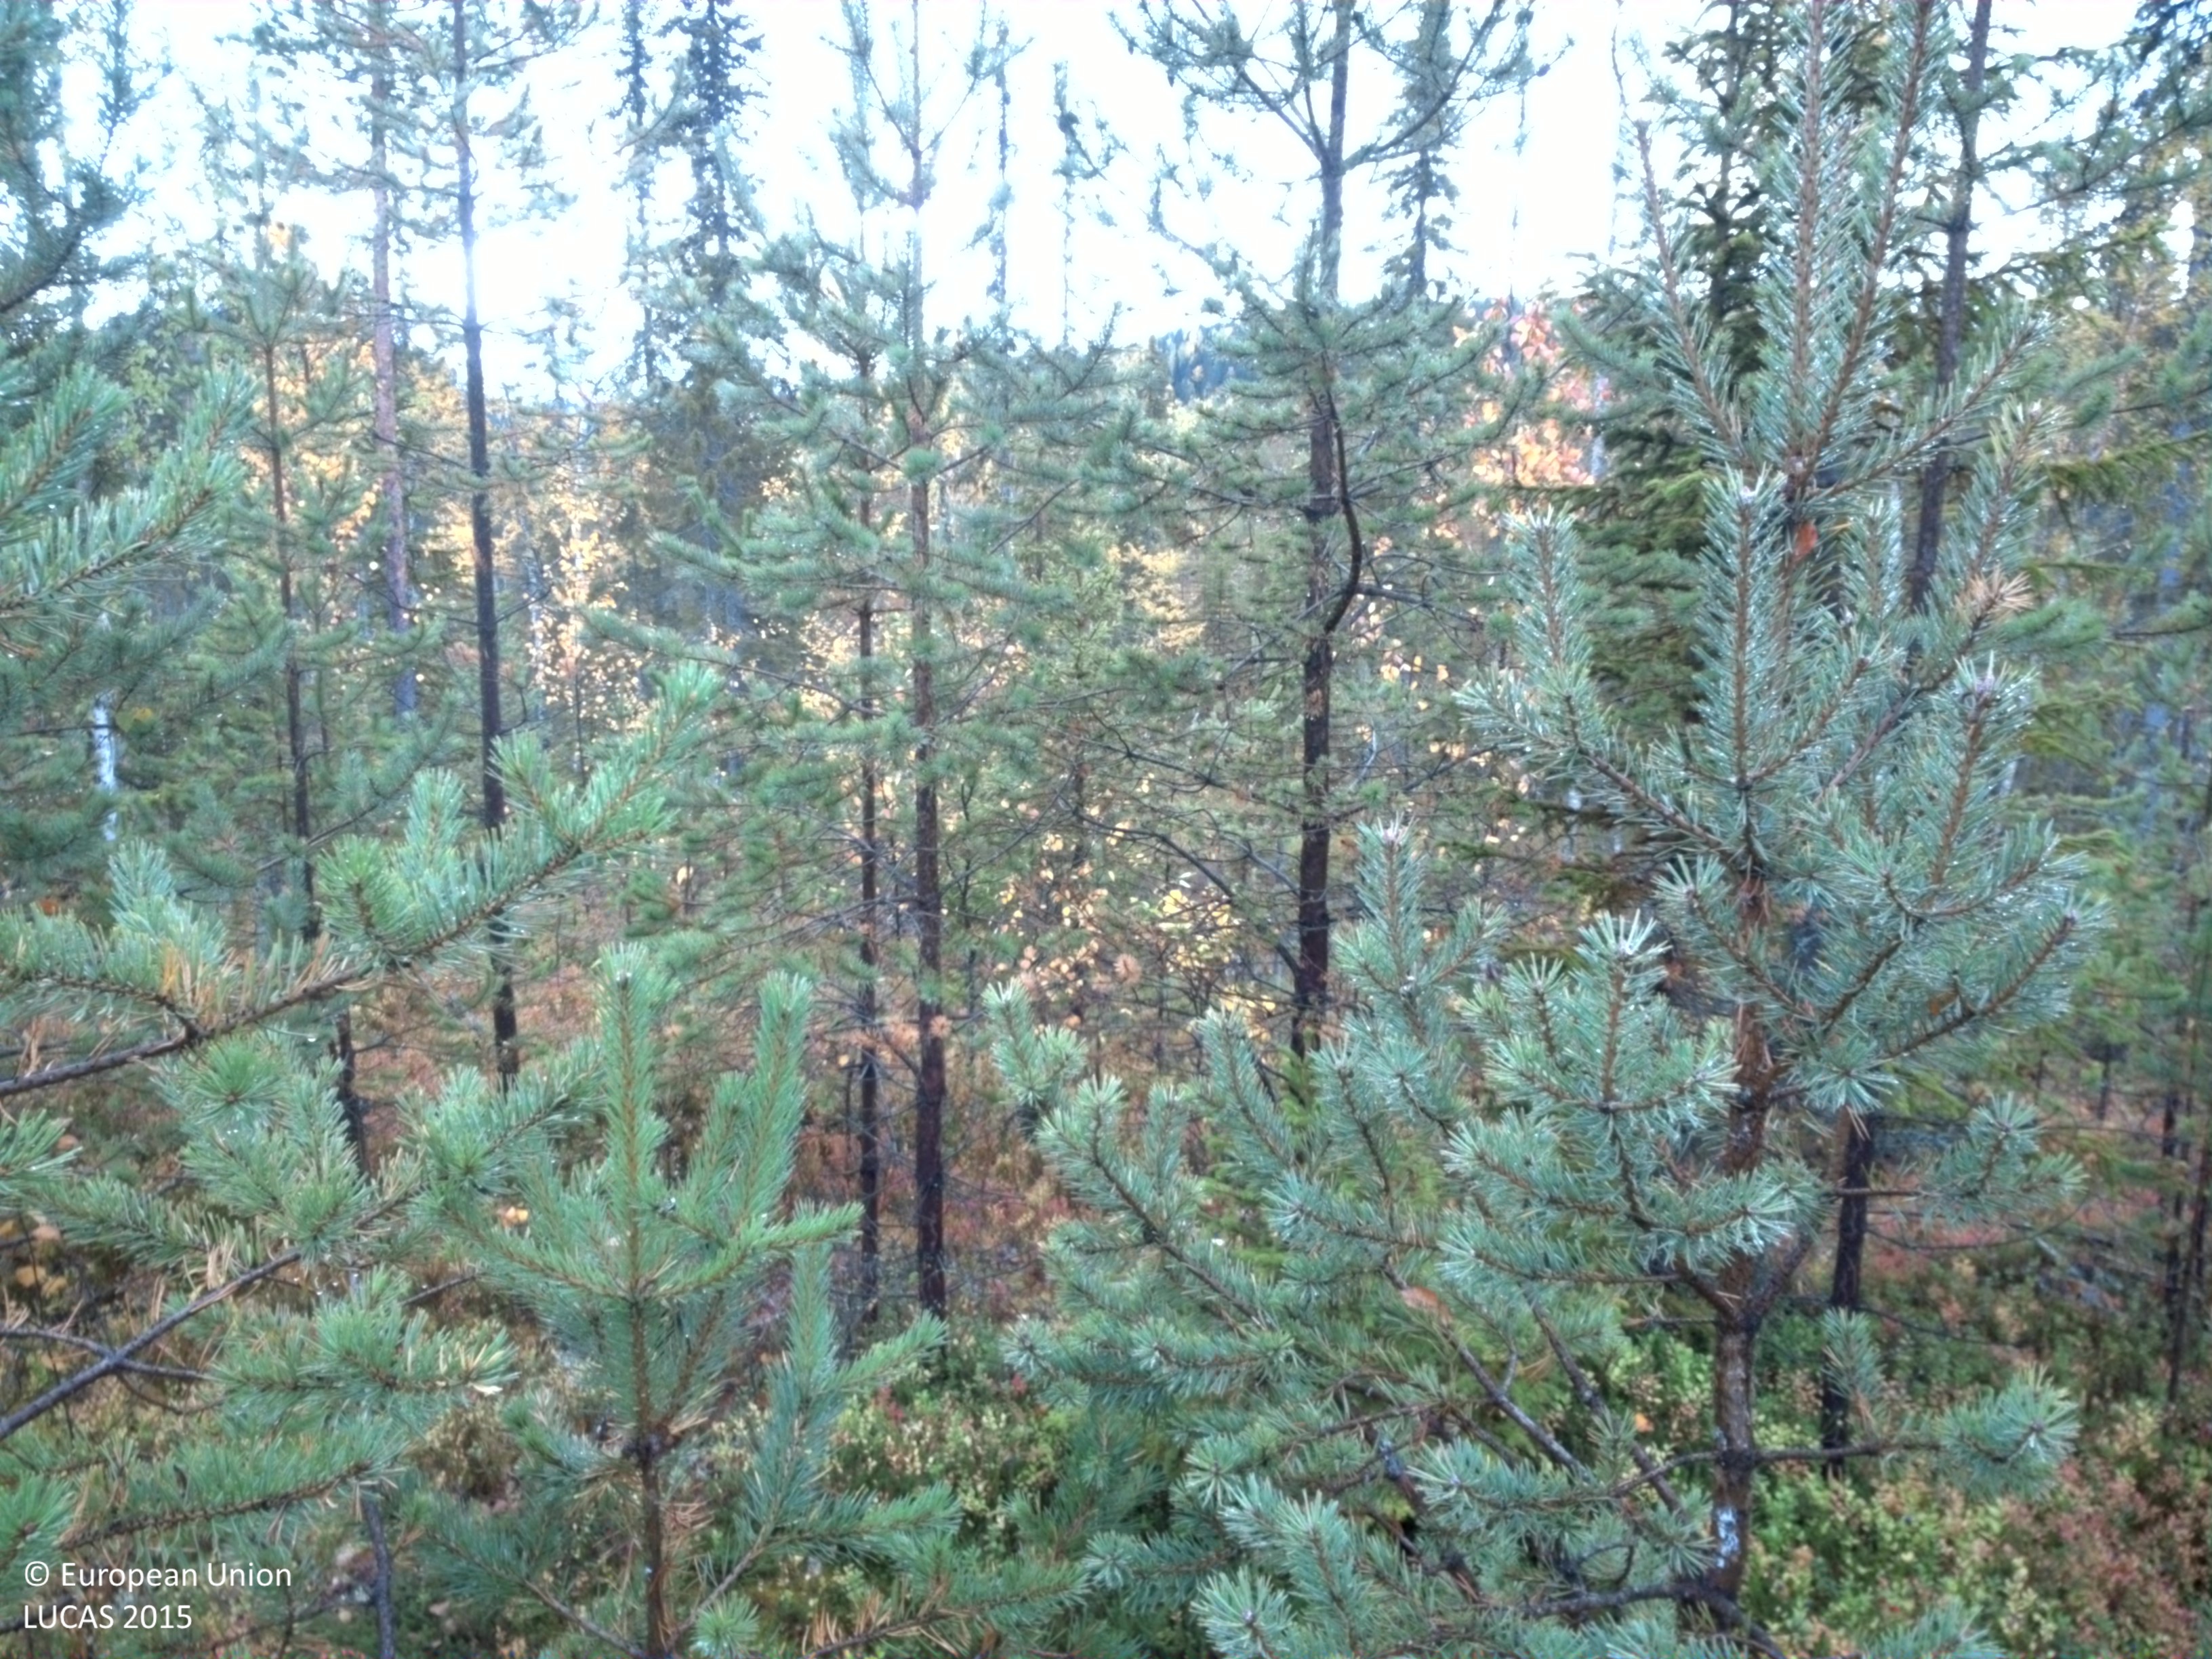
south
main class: Woodland
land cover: Pine dominated coniferous woodland
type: boreal forest
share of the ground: 25 - 50 %
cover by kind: shrubs 40 %, lichens and mosses 30 %, coniferous forest trees 20 %, broadleaved forest trees 5 %, unconsolidated bare surface 5 %
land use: Forestry
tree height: > 5 m
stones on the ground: < 10 %
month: September
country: SE
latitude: 65.0934
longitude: 17.4751
